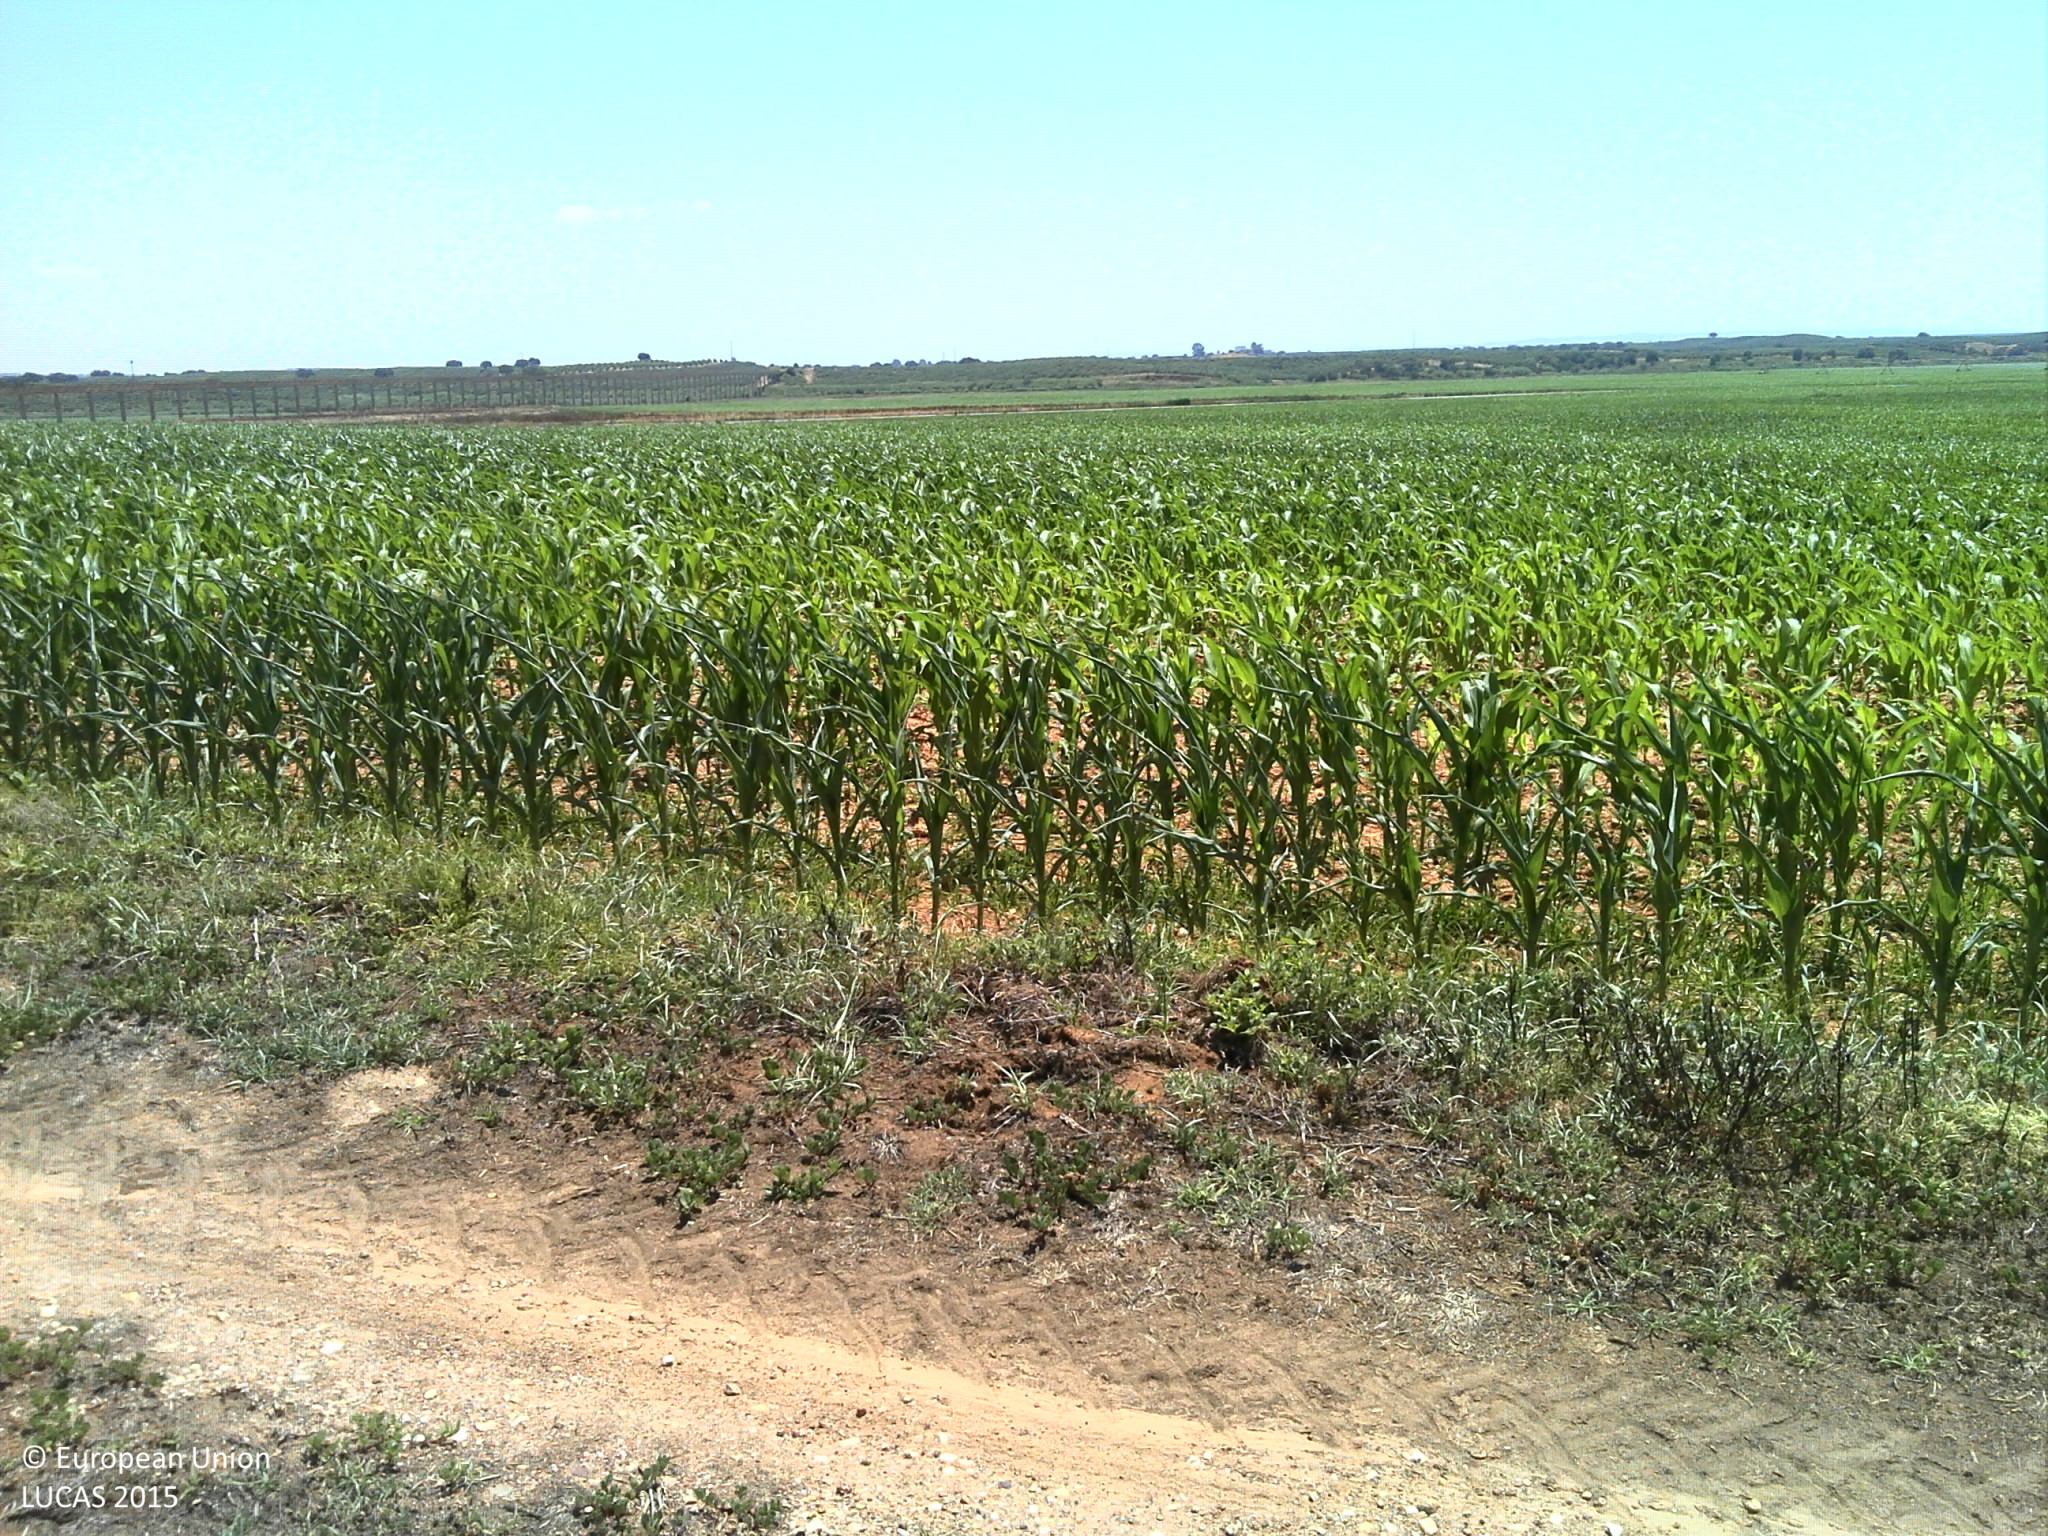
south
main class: Cropland
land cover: Maize
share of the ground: 10 - 25 %
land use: Agriculture (excluding fallow land and kitchen gardens)
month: June
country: PT
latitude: 37.9113
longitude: -8.3382
